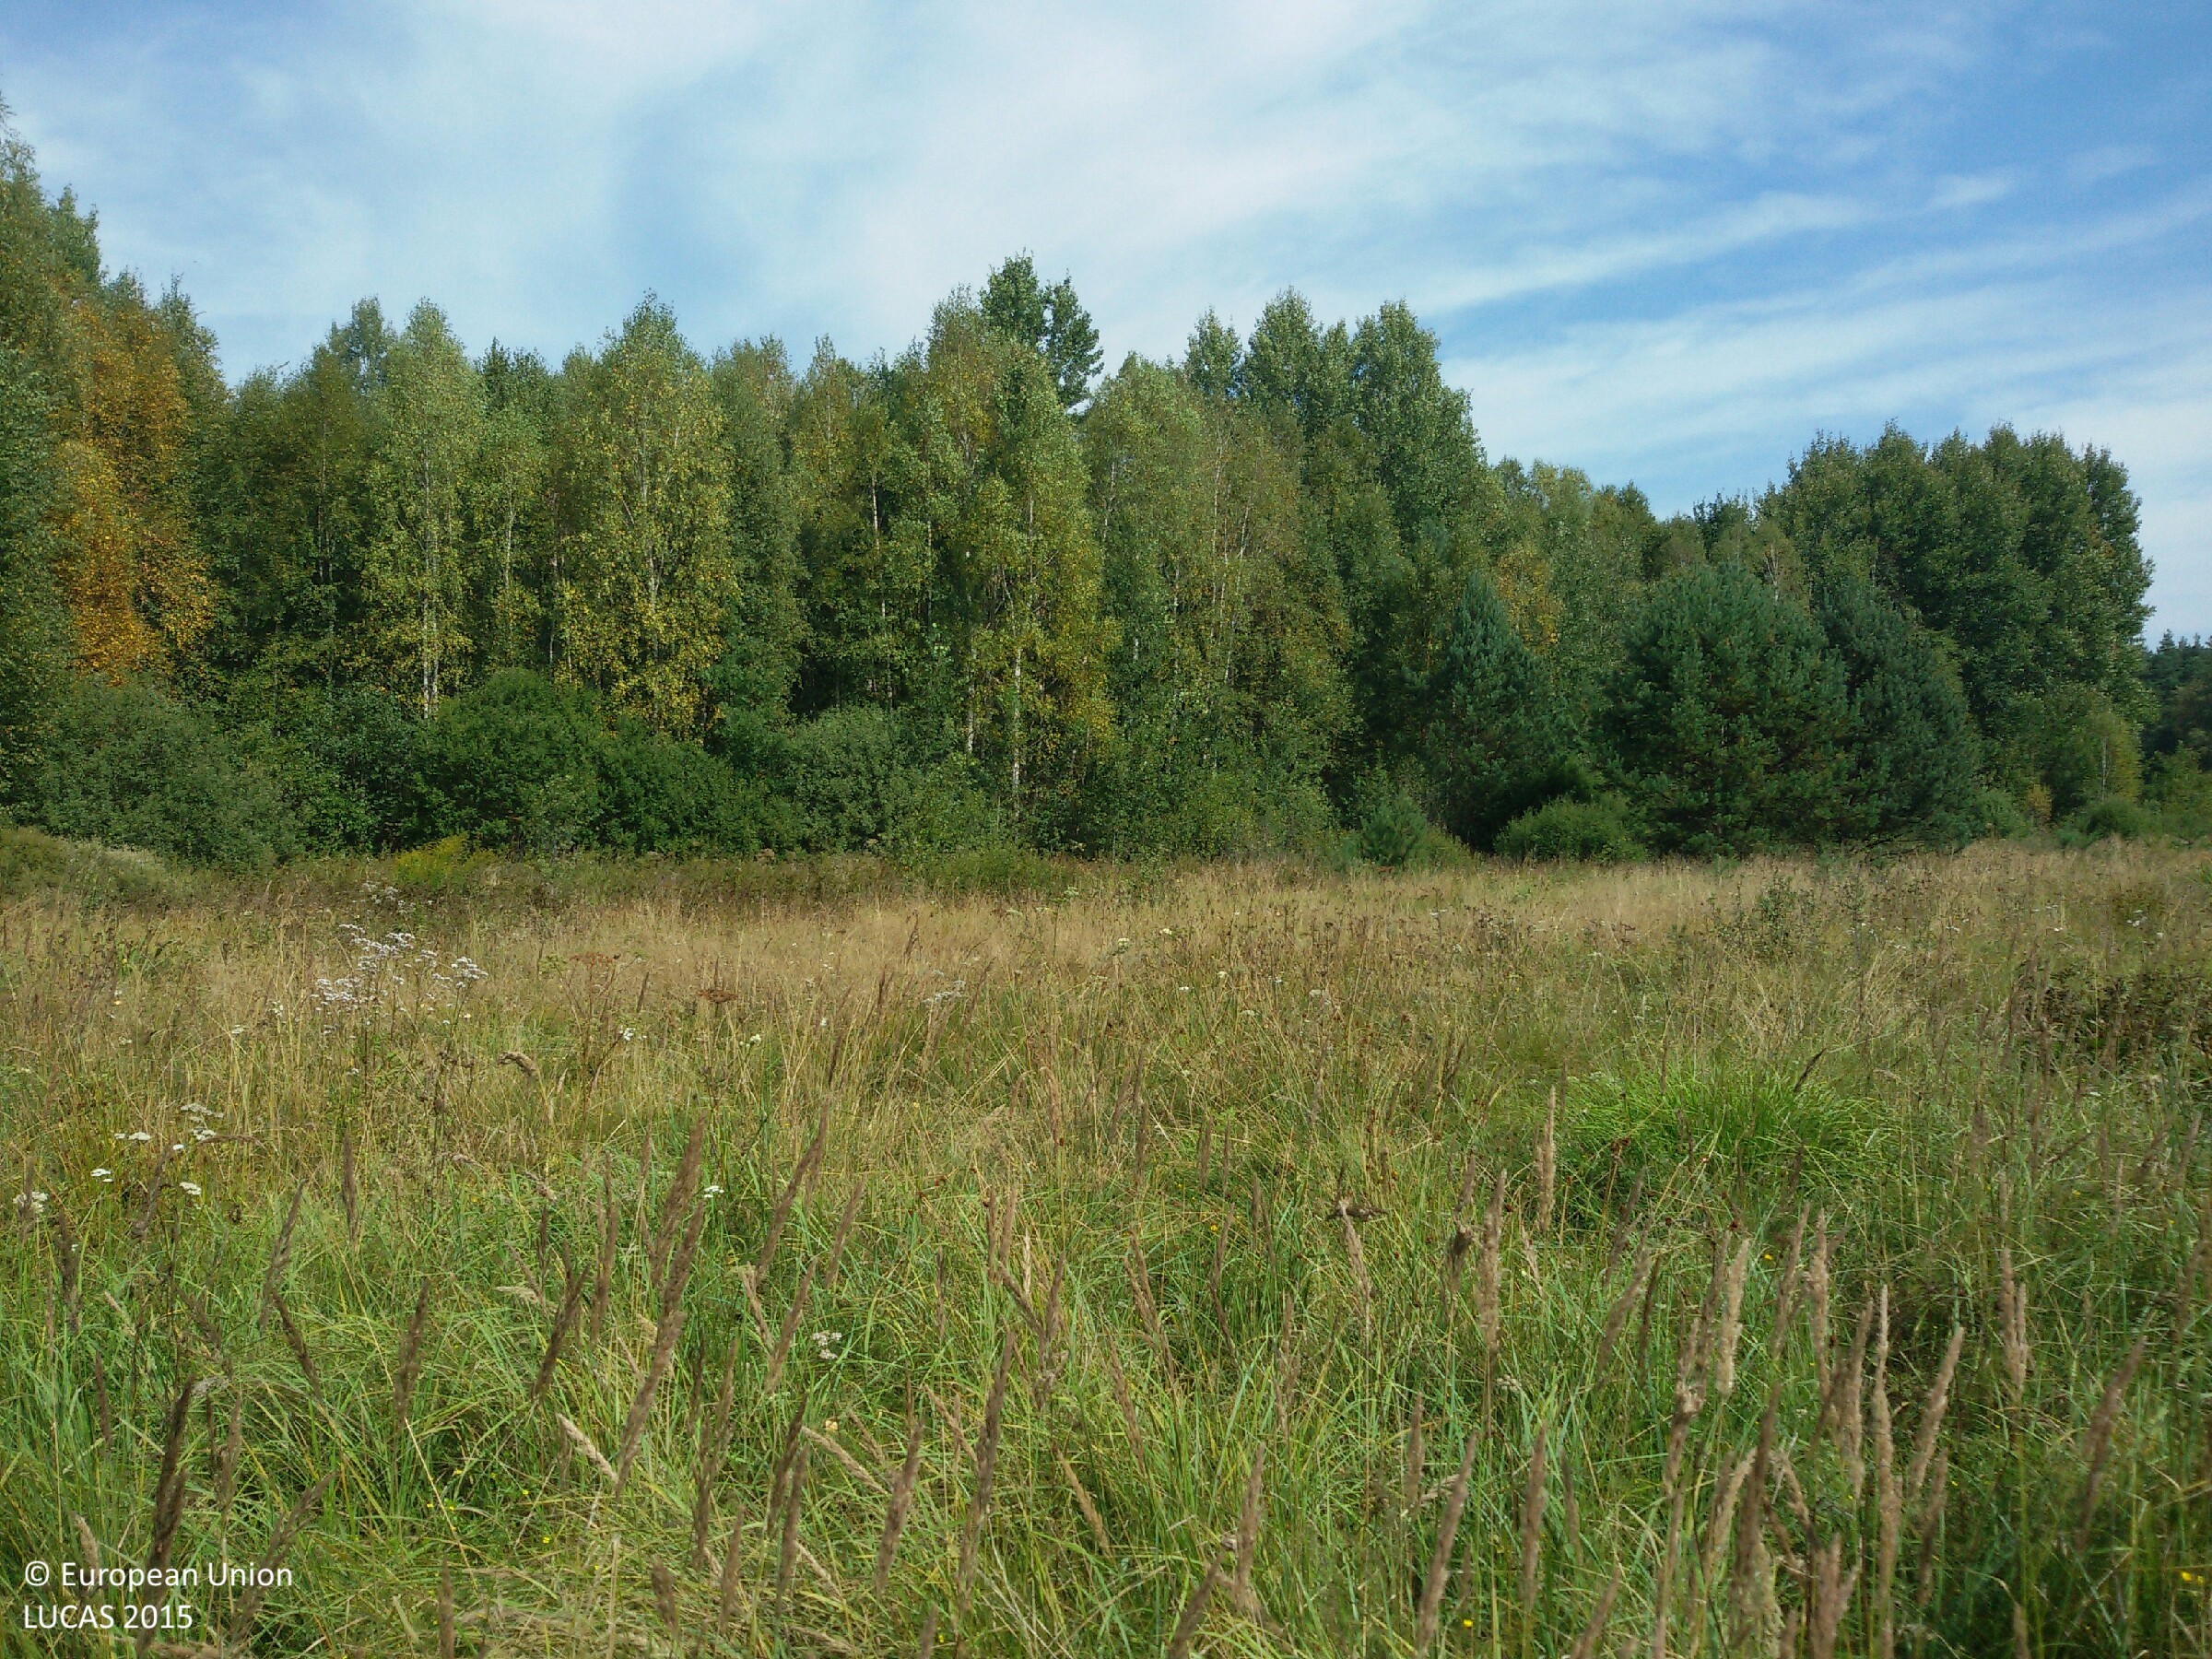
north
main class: Grassland
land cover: Grassland with sparse tree/shrub cover
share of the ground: > 75 %
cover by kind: herbaceous plants 95 %, coniferous forest trees 5 %
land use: Abandoned areas
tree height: > 5 m
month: August
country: PL
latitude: 50.7582
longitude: 20.8013
